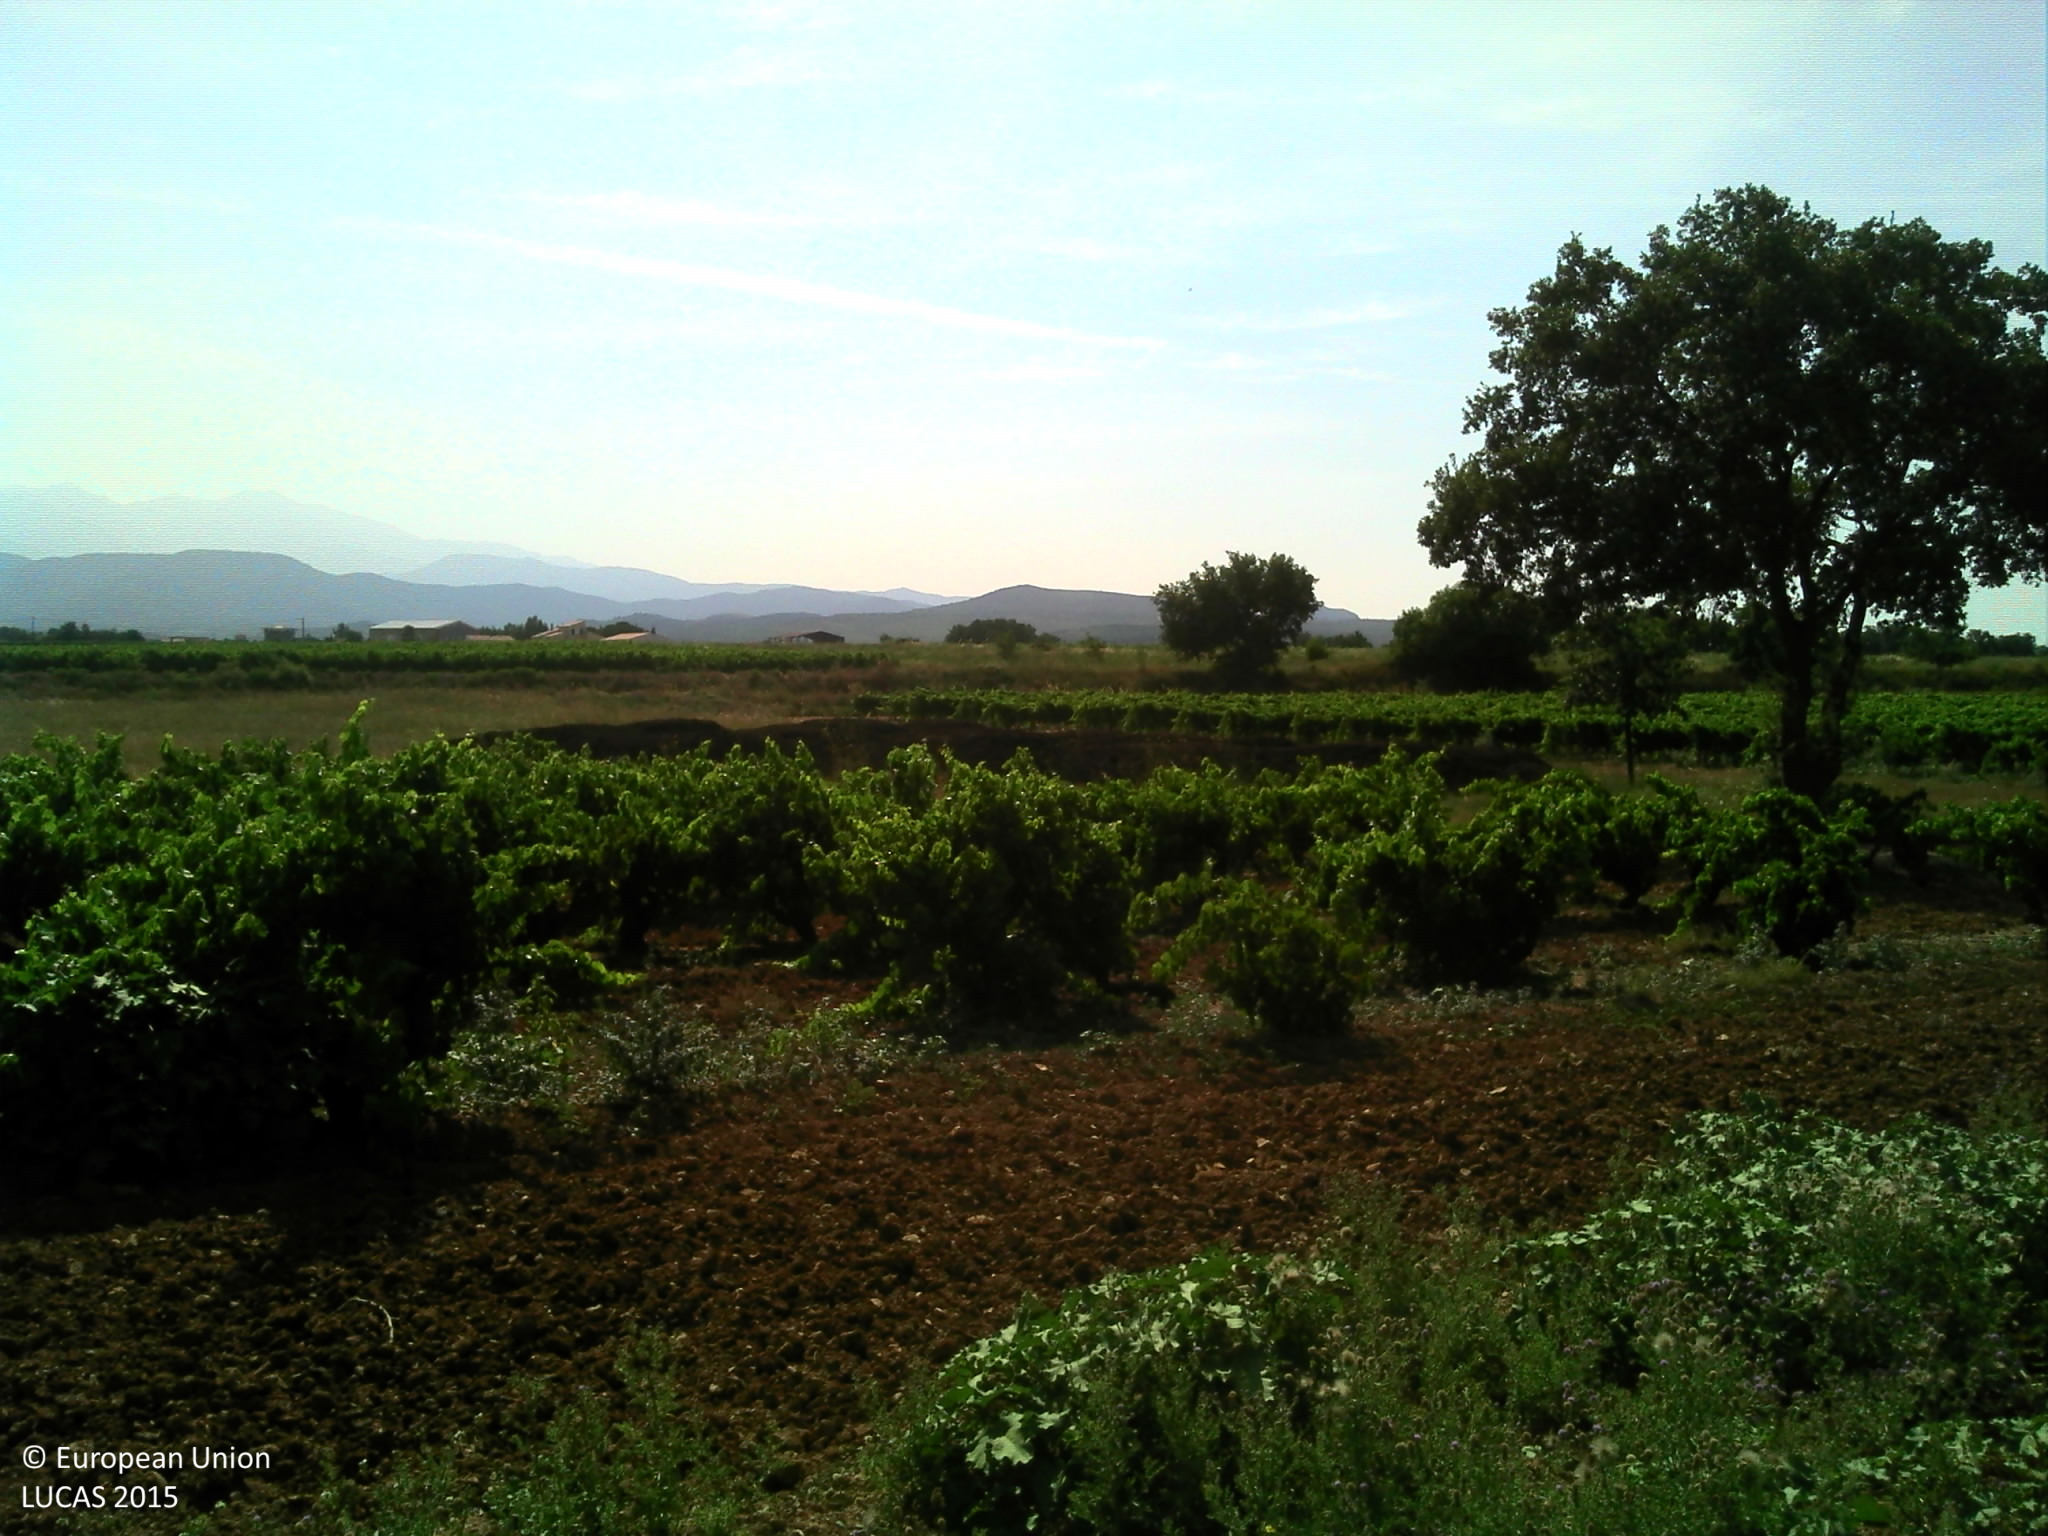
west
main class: Grassland
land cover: Spontaneously vegetated surfaces
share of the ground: 50 - 75 %
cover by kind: herbaceous plants 75 %, unconsolidated bare surface 25 %
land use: Fallow land
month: July
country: FR
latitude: 42.6139
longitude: 2.7831
